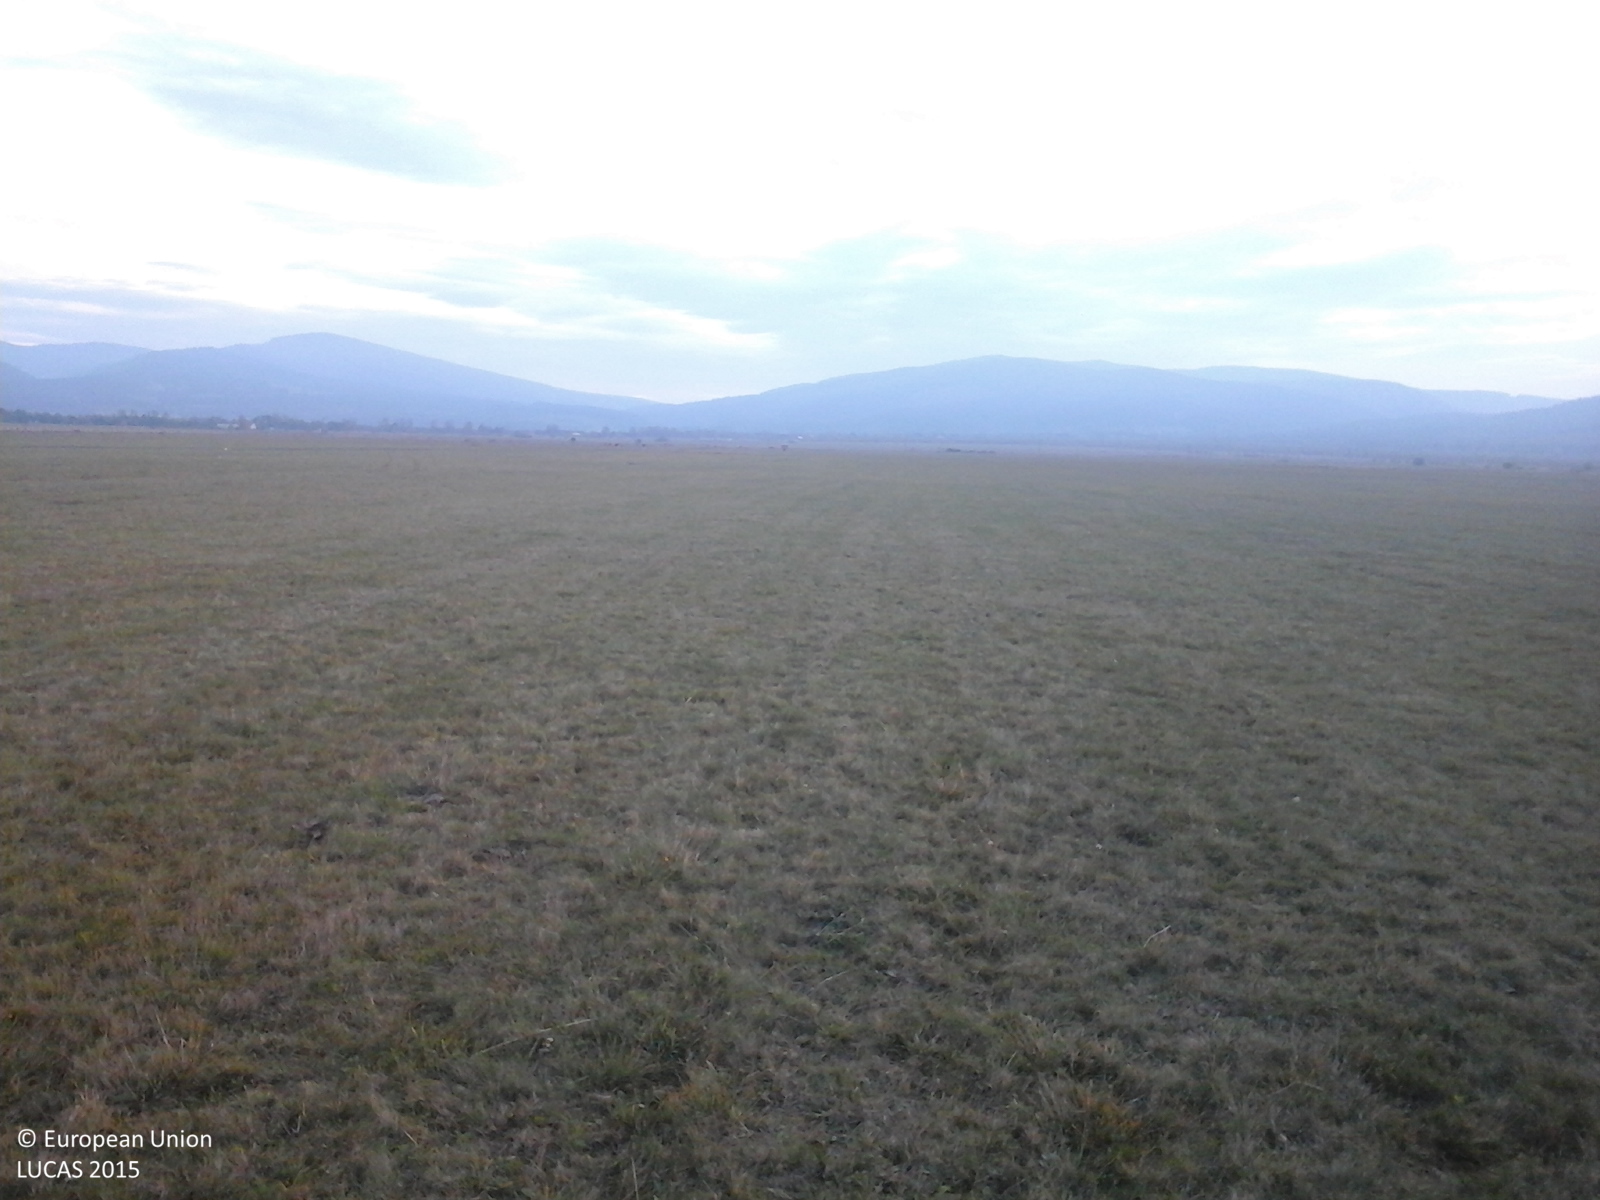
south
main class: Grassland
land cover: Grassland without tree/shrub cover
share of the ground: > 75 %
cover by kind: herbaceous plants 100 %
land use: Agriculture (excluding fallow land and kitchen gardens)
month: October
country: RO
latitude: 46.7079
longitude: 25.4255
